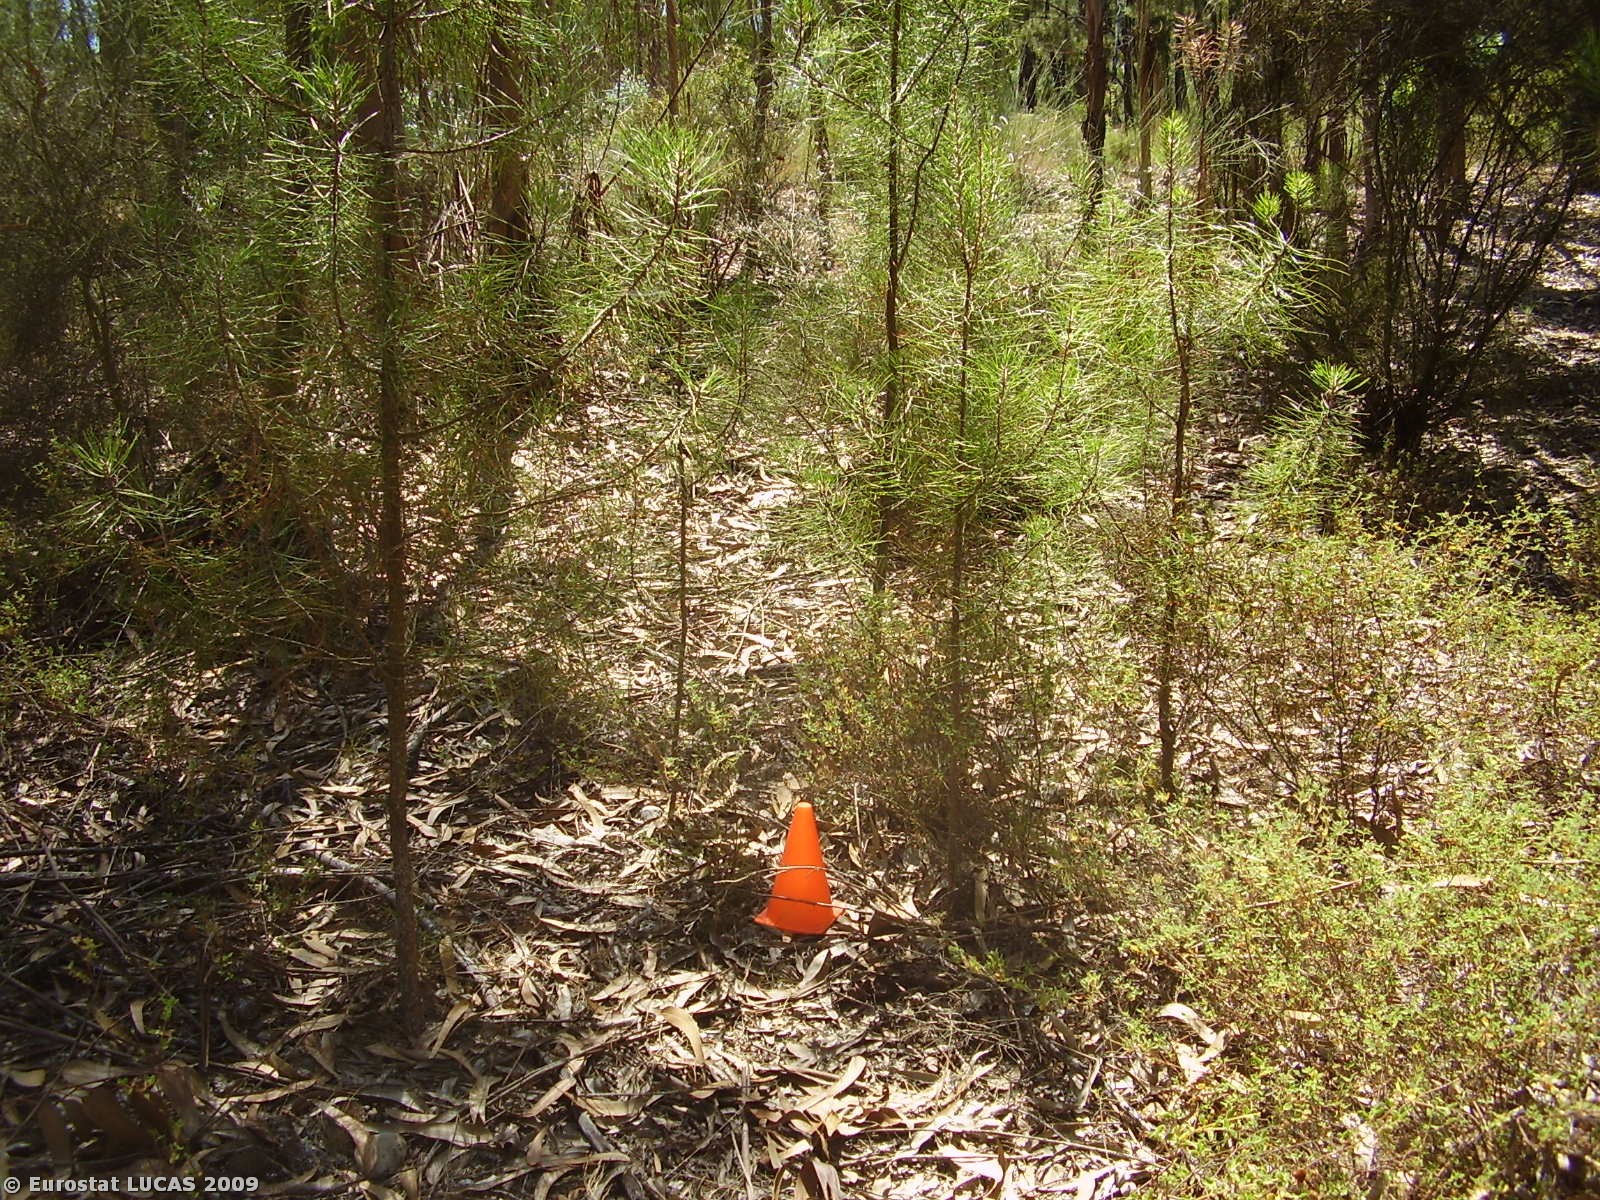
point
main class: Woodland
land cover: Mixed woodland
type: plantations and self-sown exotic forest
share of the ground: 25 - 50 %
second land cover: Spontaneously vegetated surfaces
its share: 50 - 75 %
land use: Forestry
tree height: > 5 m
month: July
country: PT
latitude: 39.3521
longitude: -7.9611
